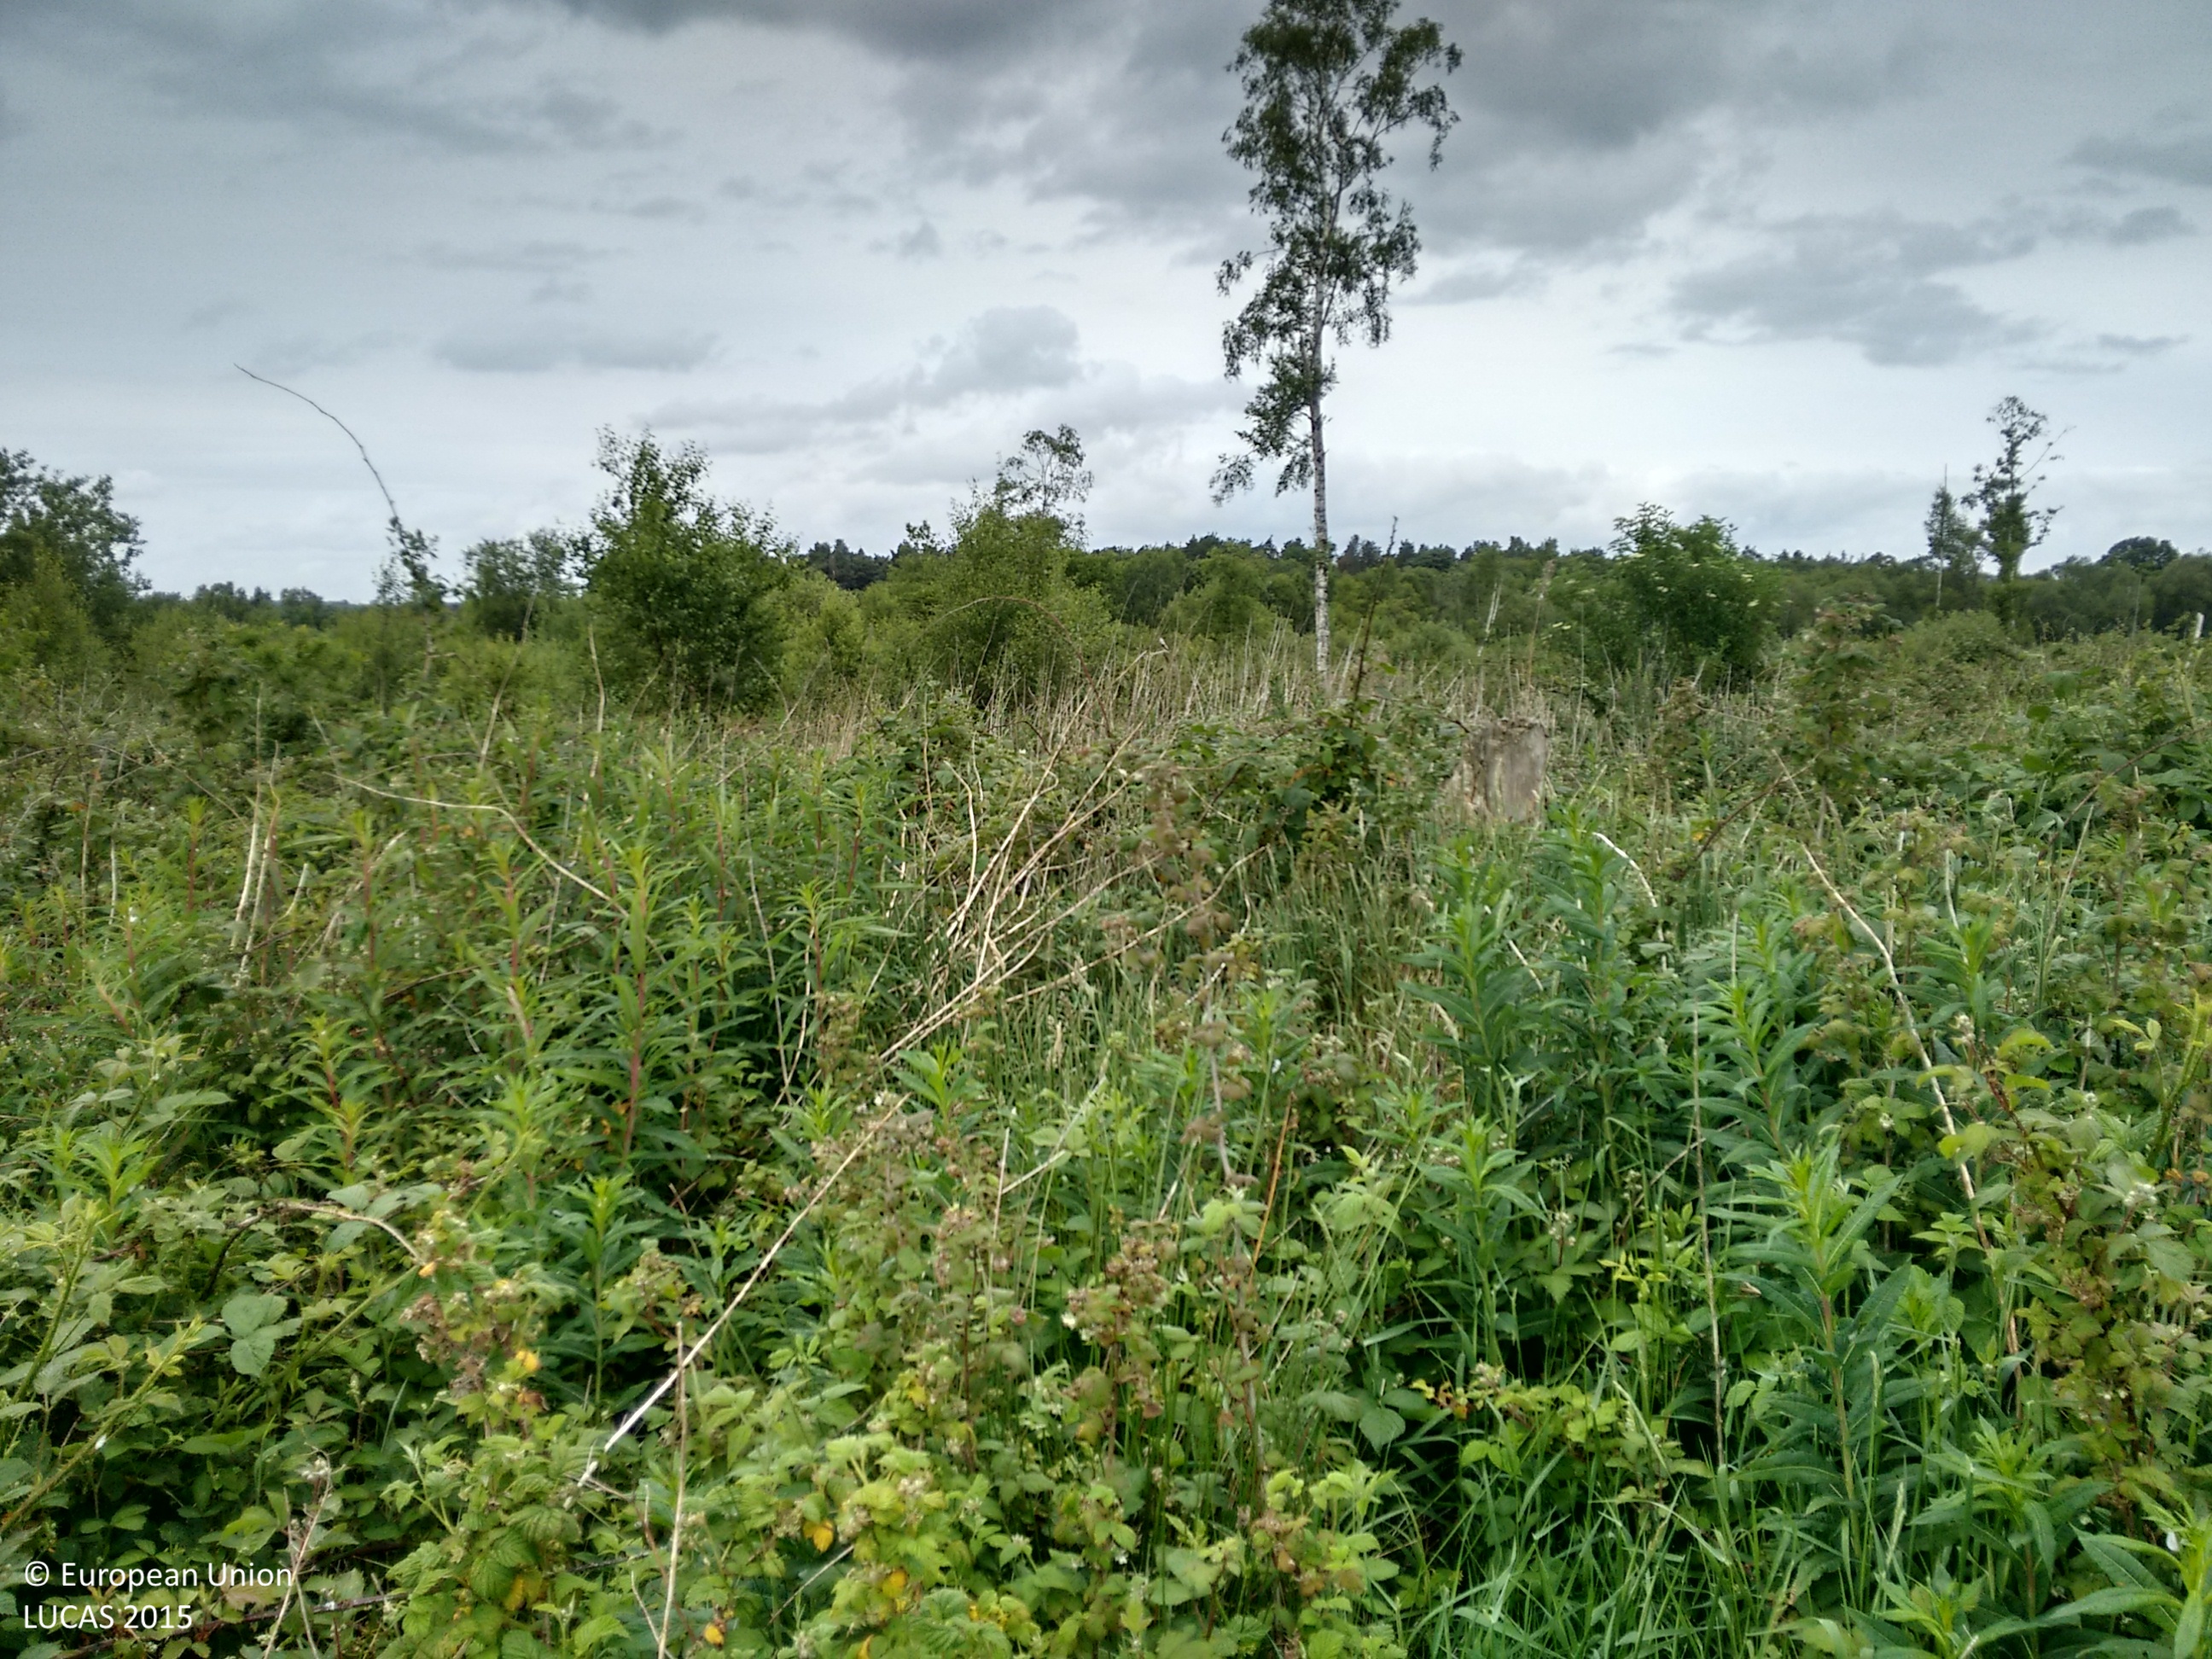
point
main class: Shrubland
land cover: Shrubland without tree cover
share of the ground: > 75 %
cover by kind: herbaceous plants 80 %, shrubs 20 %
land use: Forestry
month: June
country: IE
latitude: 53.7468
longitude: -6.7689
